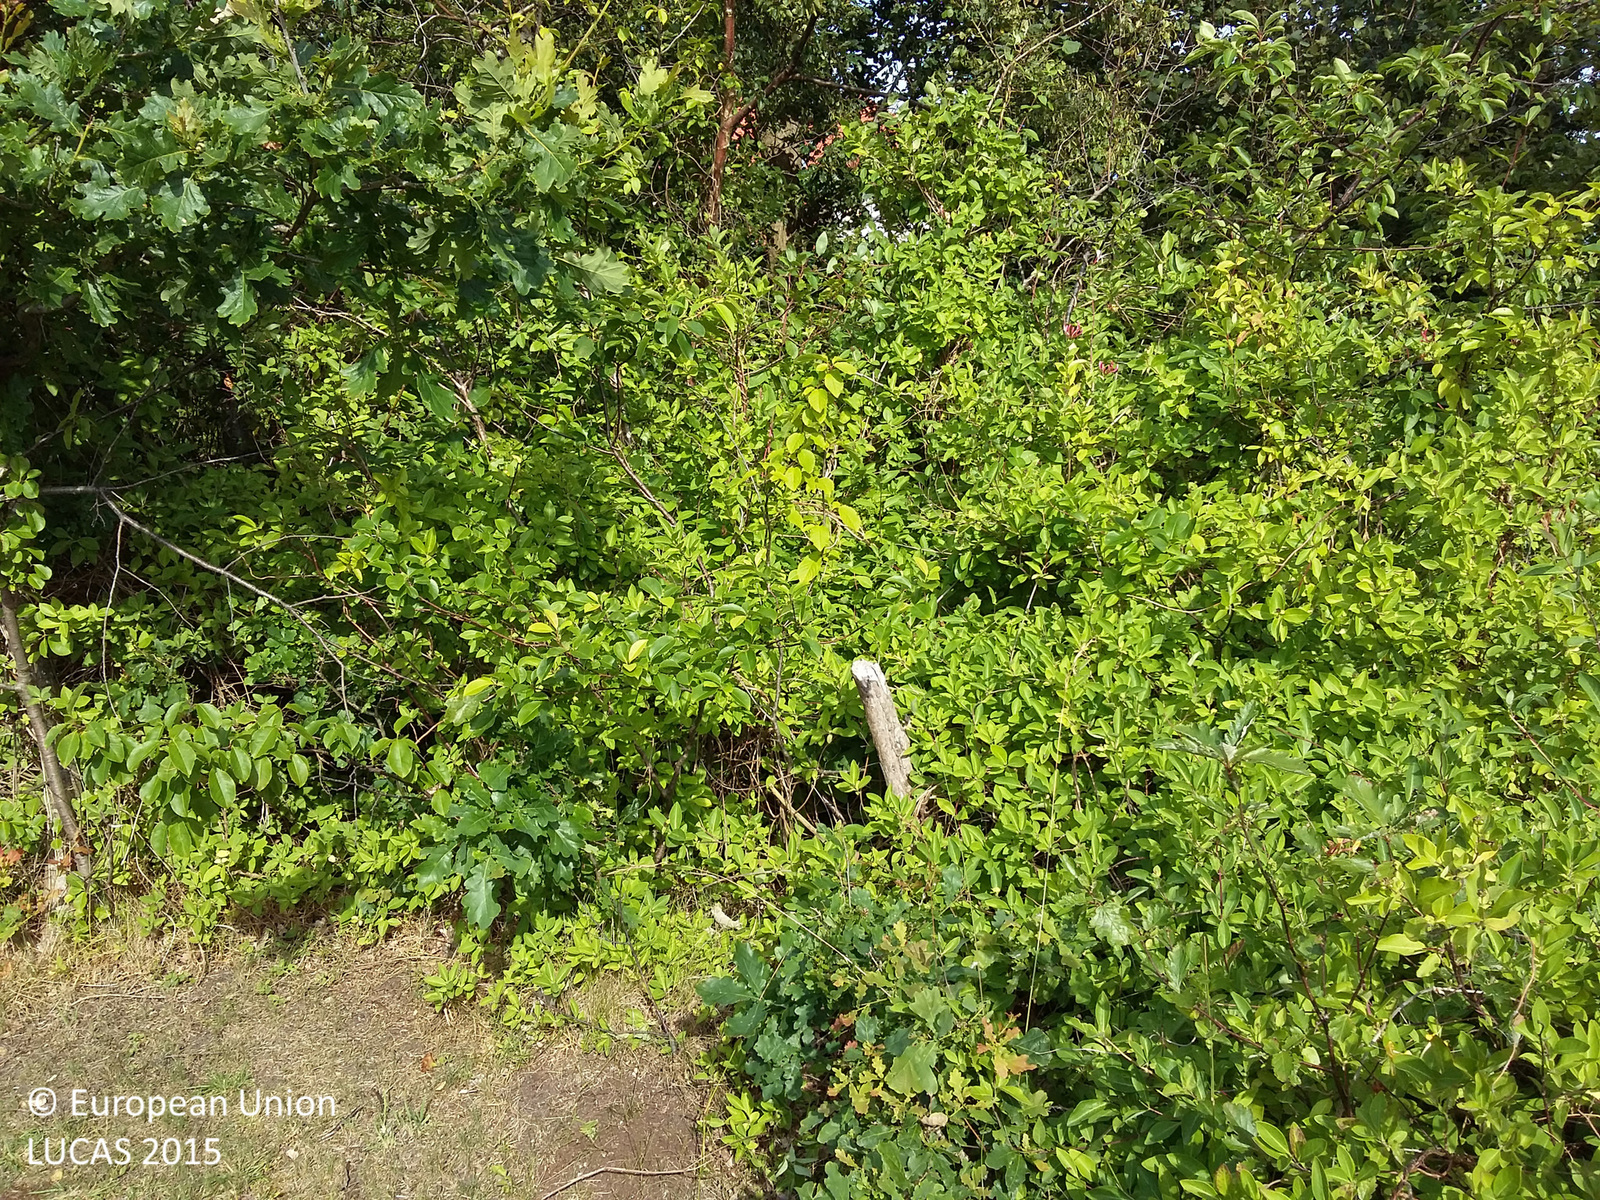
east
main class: Woodland
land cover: Broadleaved woodland
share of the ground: > 75 %
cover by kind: broadleaved forest trees 80 %, herbaceous plants 20 %
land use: Residential
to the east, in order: Broadleaved woodland; Artificial constructions in urban areas
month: July
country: DK
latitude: 56.0975
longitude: 12.1680
